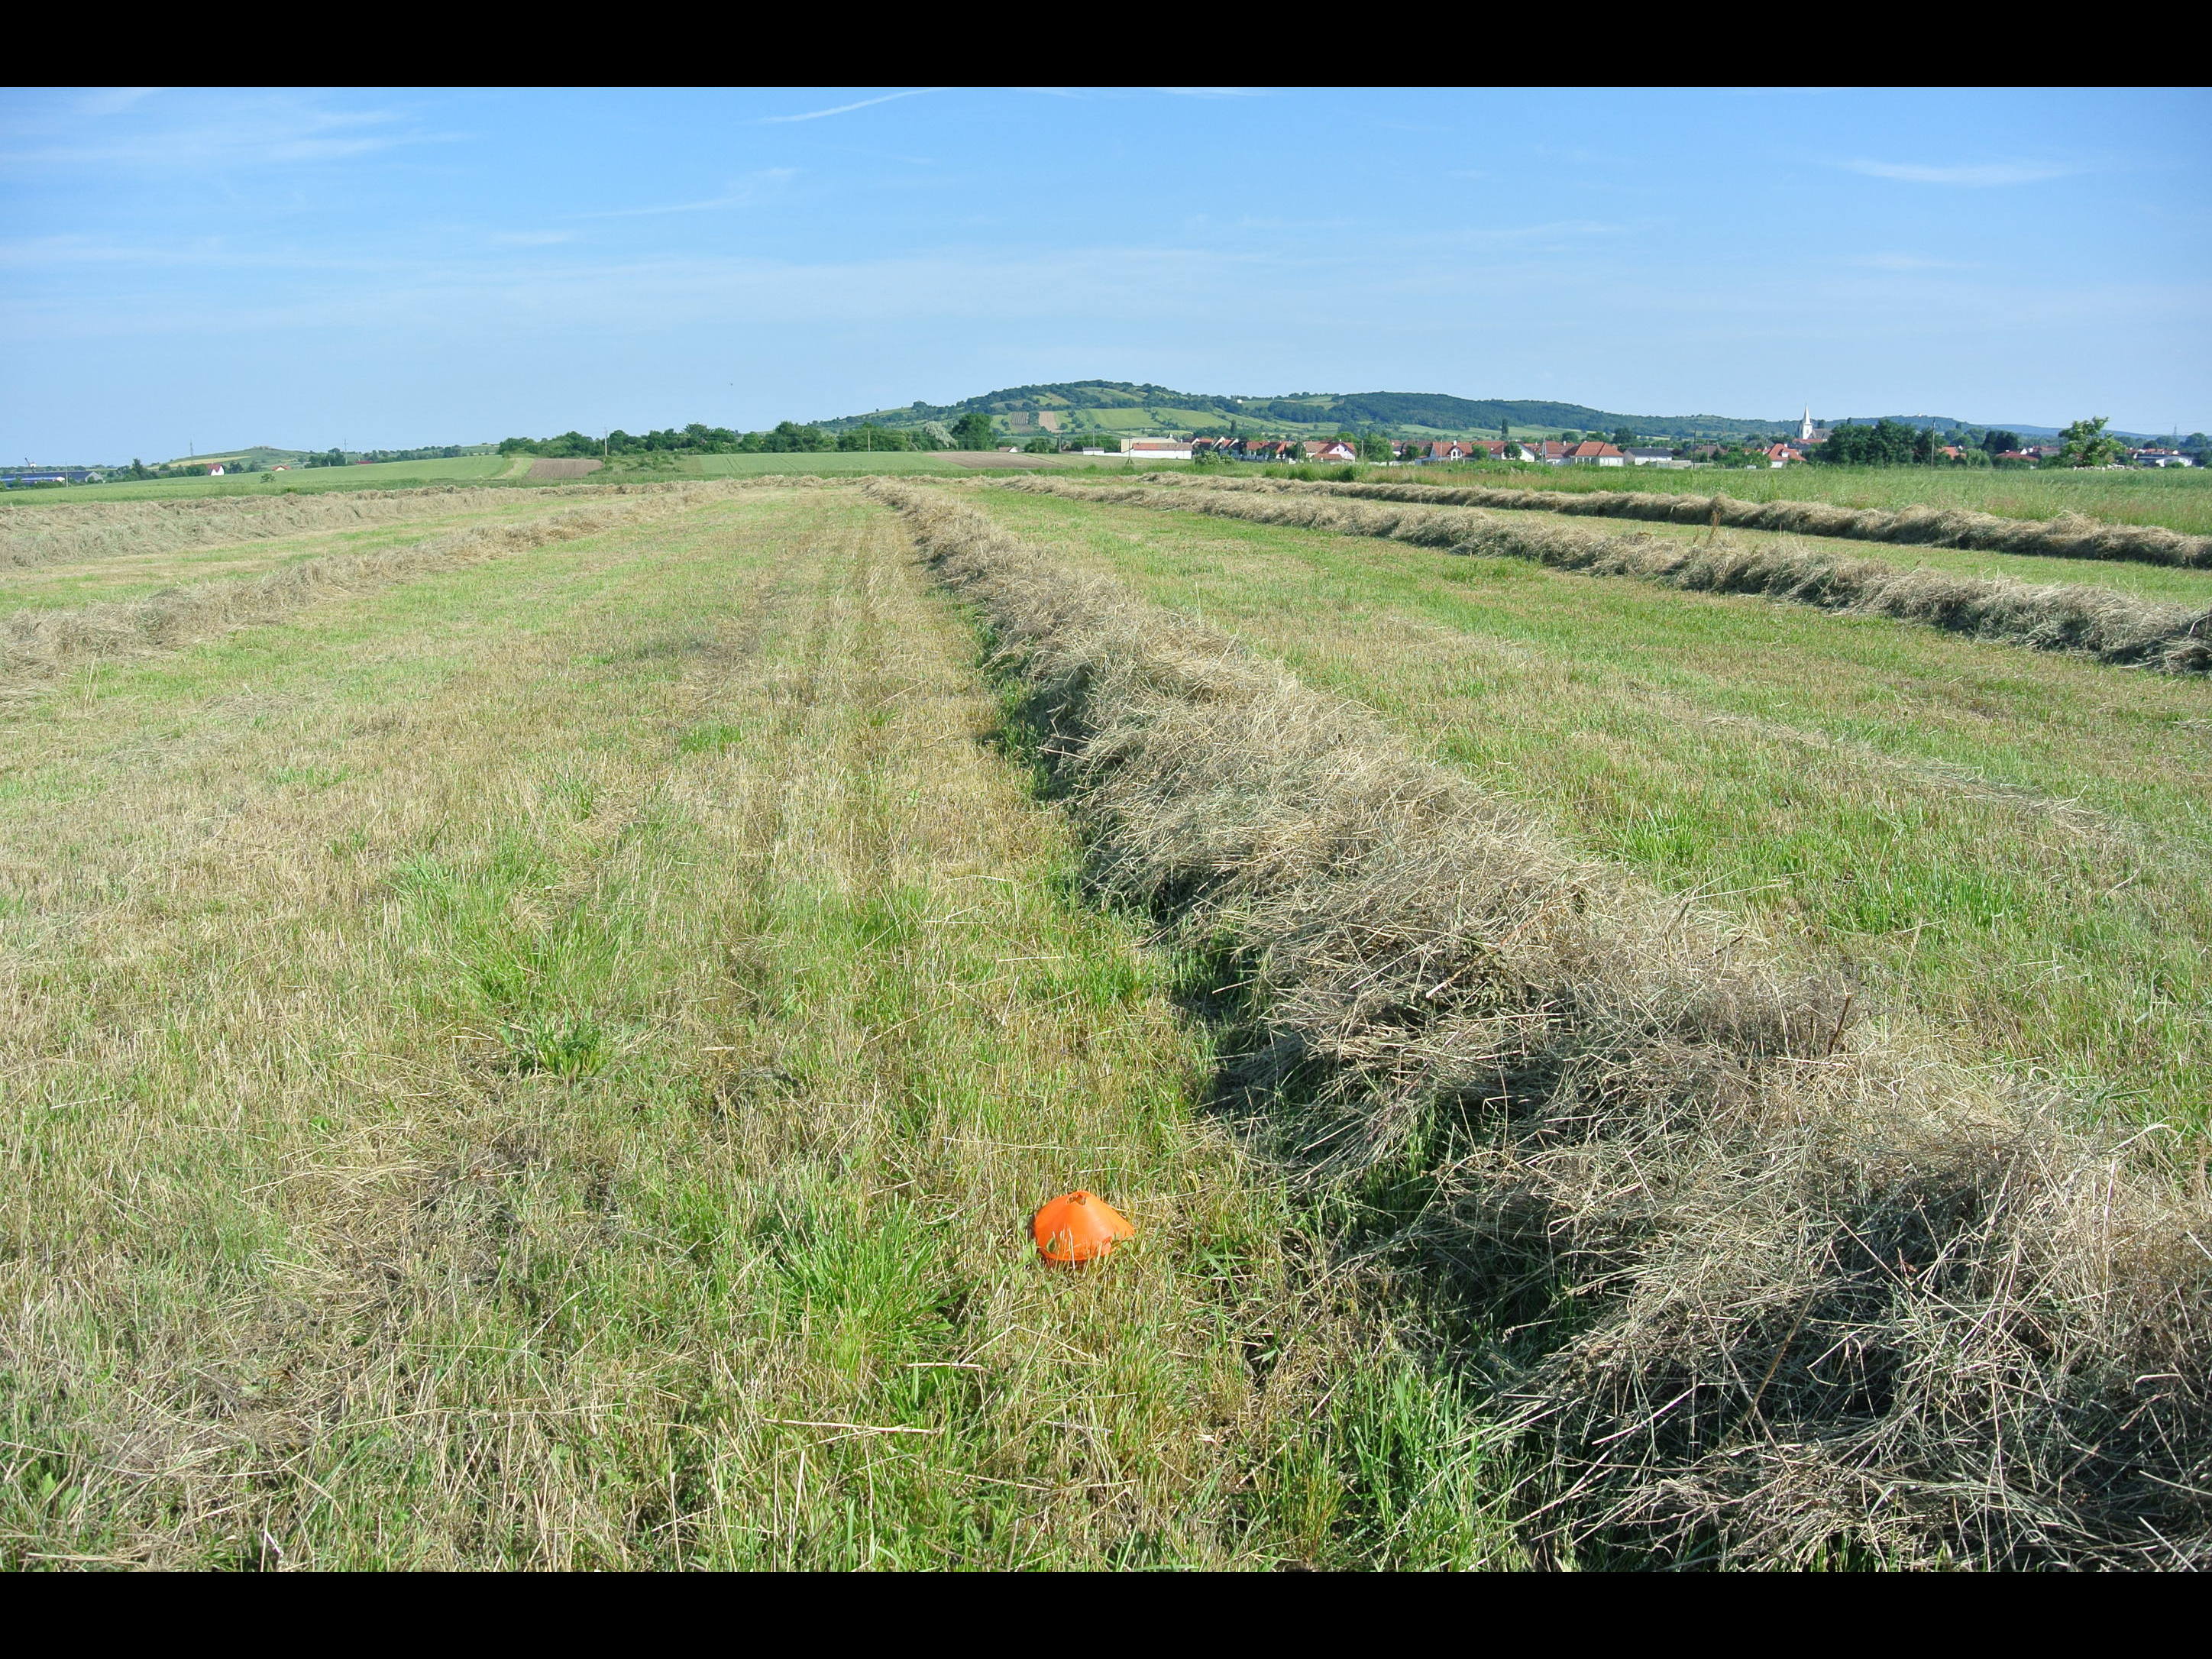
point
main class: Grassland
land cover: Grassland without tree/shrub cover
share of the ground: > 75 %
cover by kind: herbaceous plants 100 %
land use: Agriculture (excluding fallow land and kitchen gardens)
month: June
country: AT
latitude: 47.8619
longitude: 16.6218
